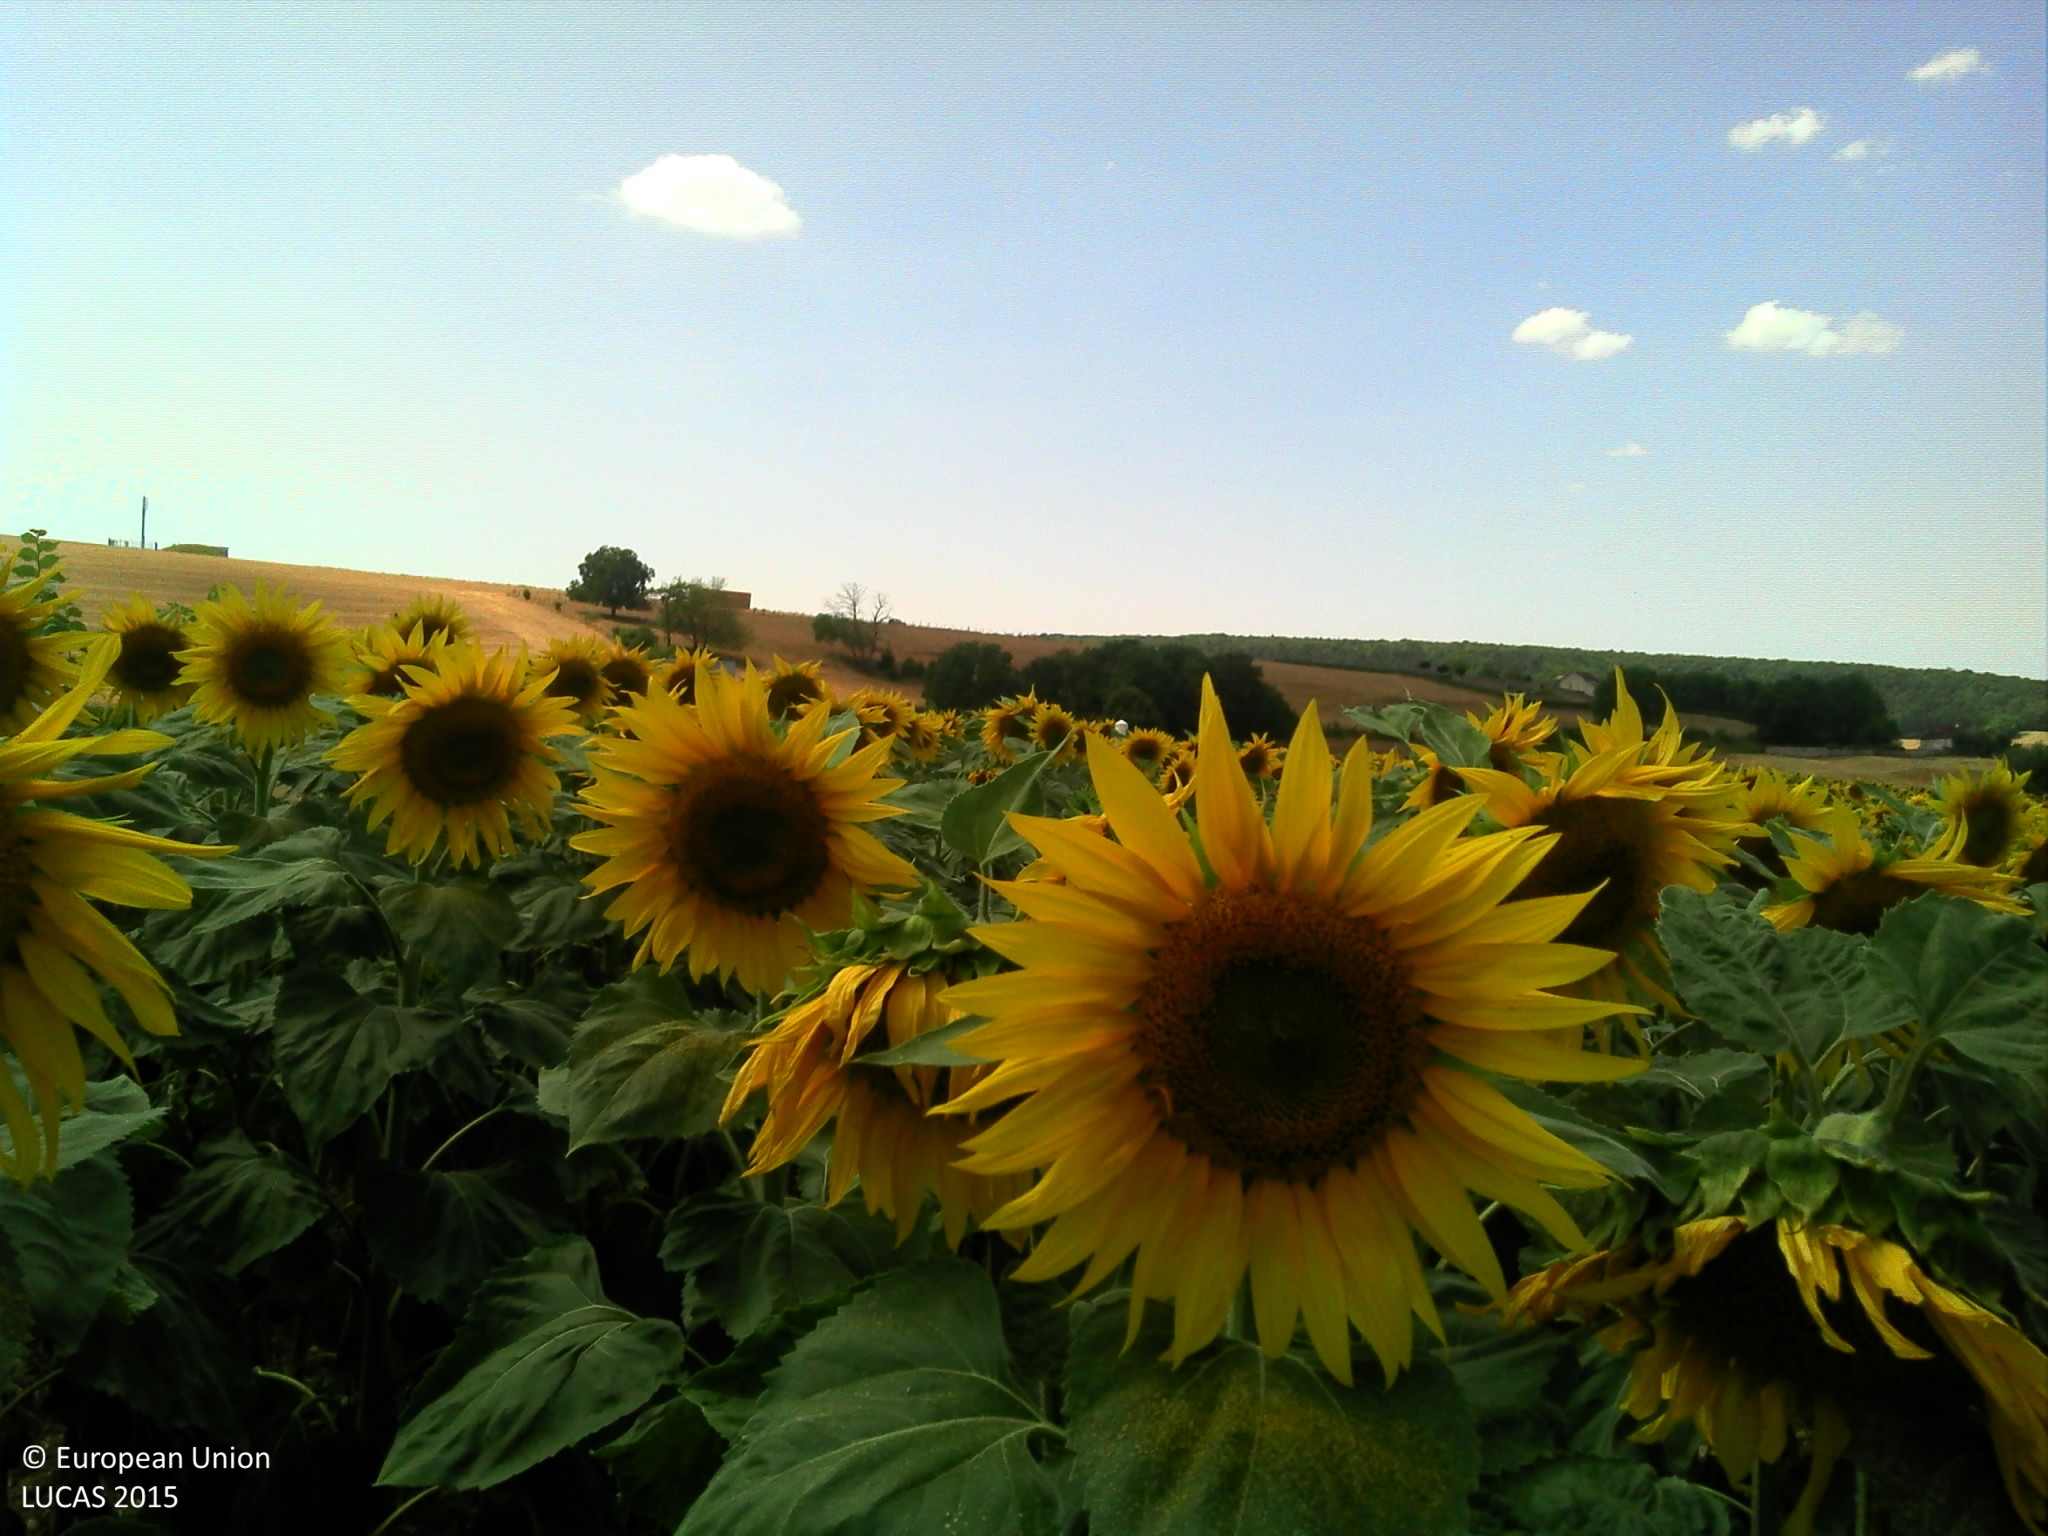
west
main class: Cropland
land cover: Sunflower
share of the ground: > 75 %
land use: Agriculture (excluding fallow land and kitchen gardens)
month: July
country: FR
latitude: 48.1047
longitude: 4.8820
